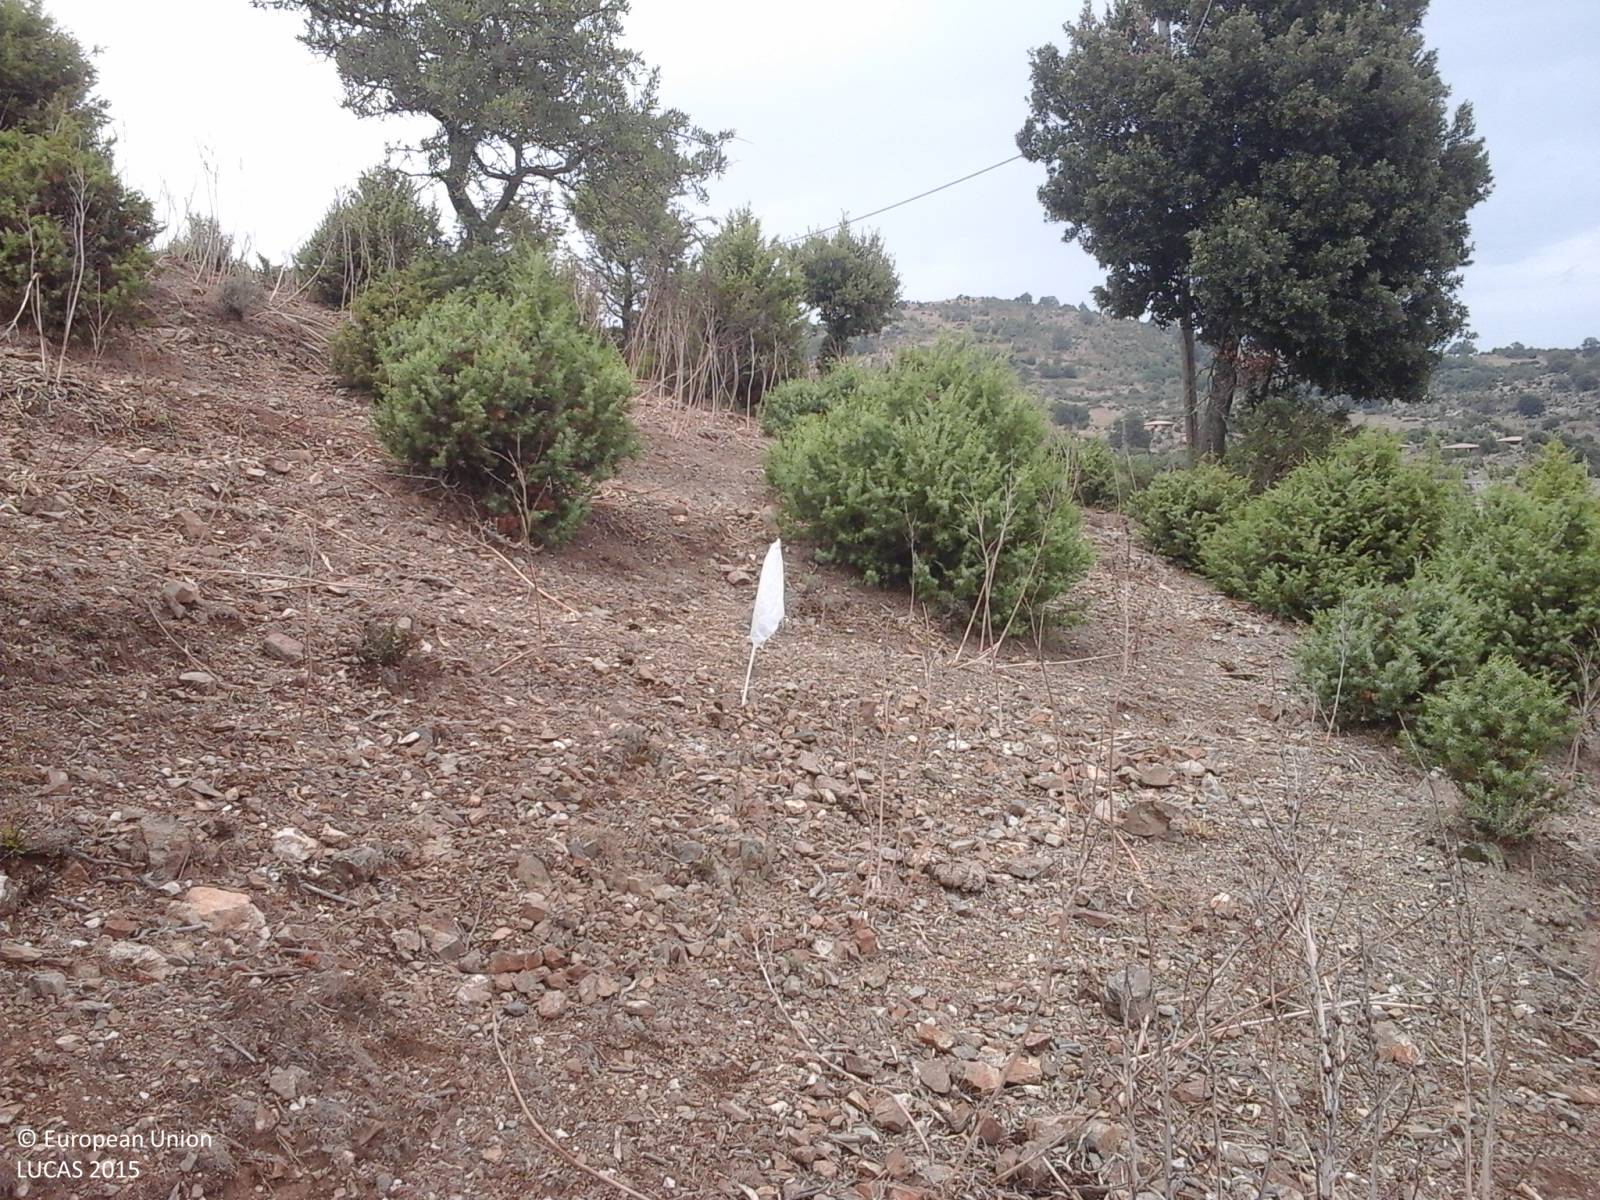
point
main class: Shrubland
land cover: Shrubland with sparse tree cover
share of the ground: > 75 %
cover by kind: unconsolidated bare surface 50 %, shrubs 35 %, broadleaved forest trees 5 %, herbaceous plants 5 %, consolidated bare surface 5 %
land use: Agriculture (excluding fallow land and kitchen gardens)
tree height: < 5 m
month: September
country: IT
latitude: 39.9579
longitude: 9.4296
